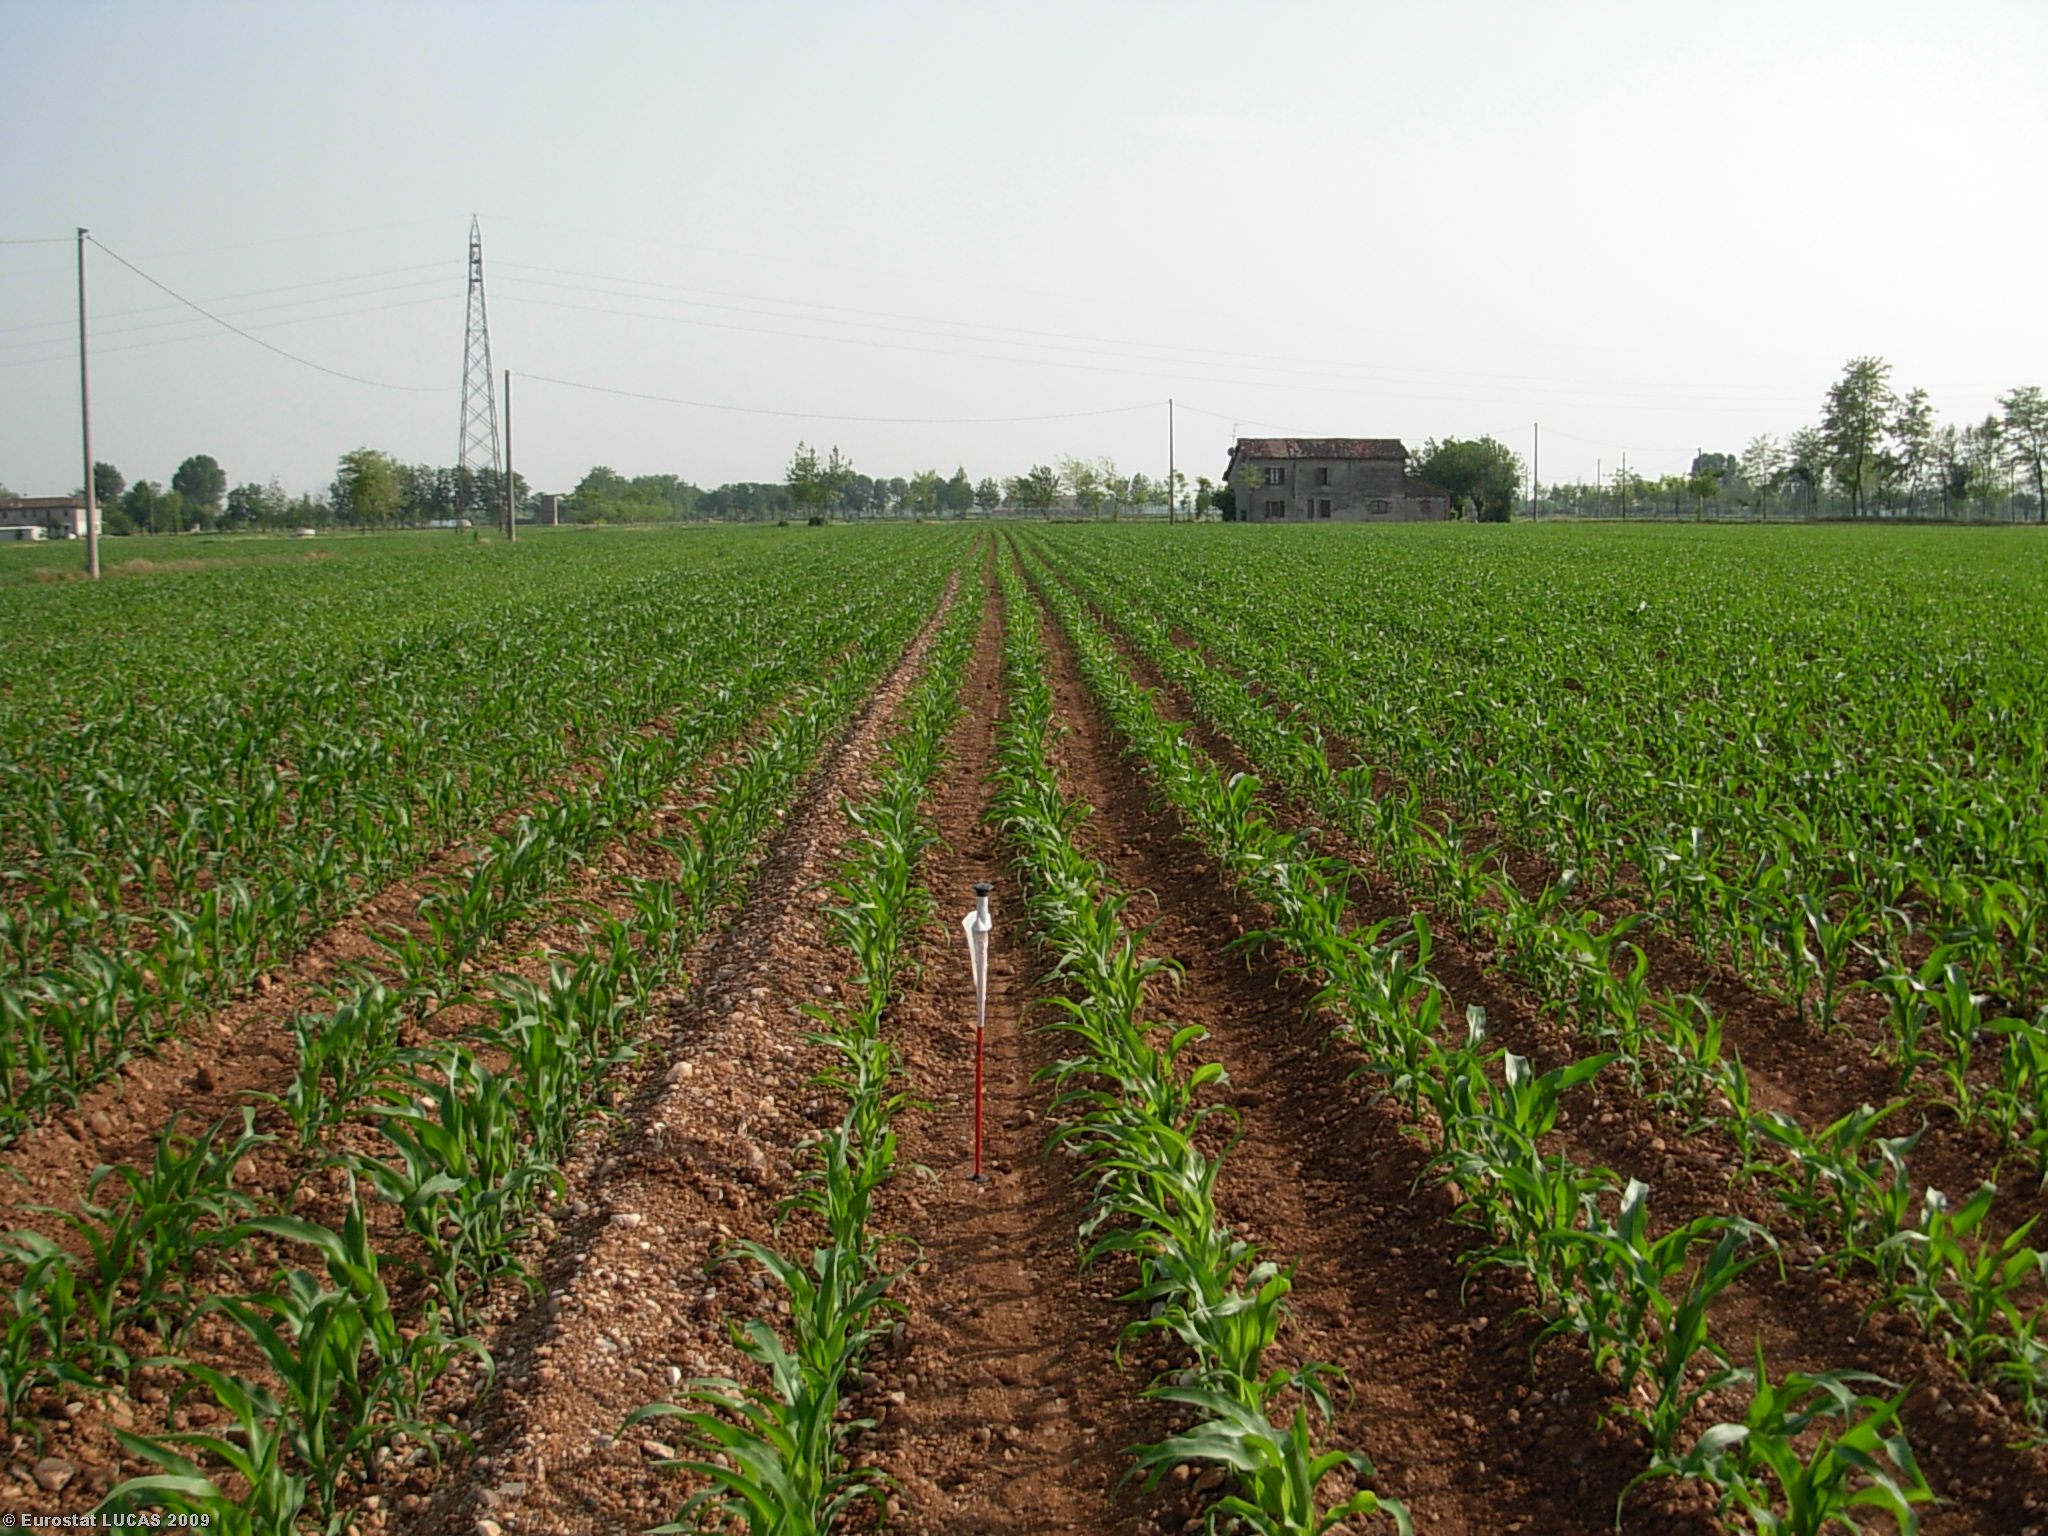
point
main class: Cropland
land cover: Maize
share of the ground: 50 - 75 %
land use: Agriculture (excluding fallow land and kitchen gardens)
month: May
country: IT
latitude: 45.3958
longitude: 10.3188
